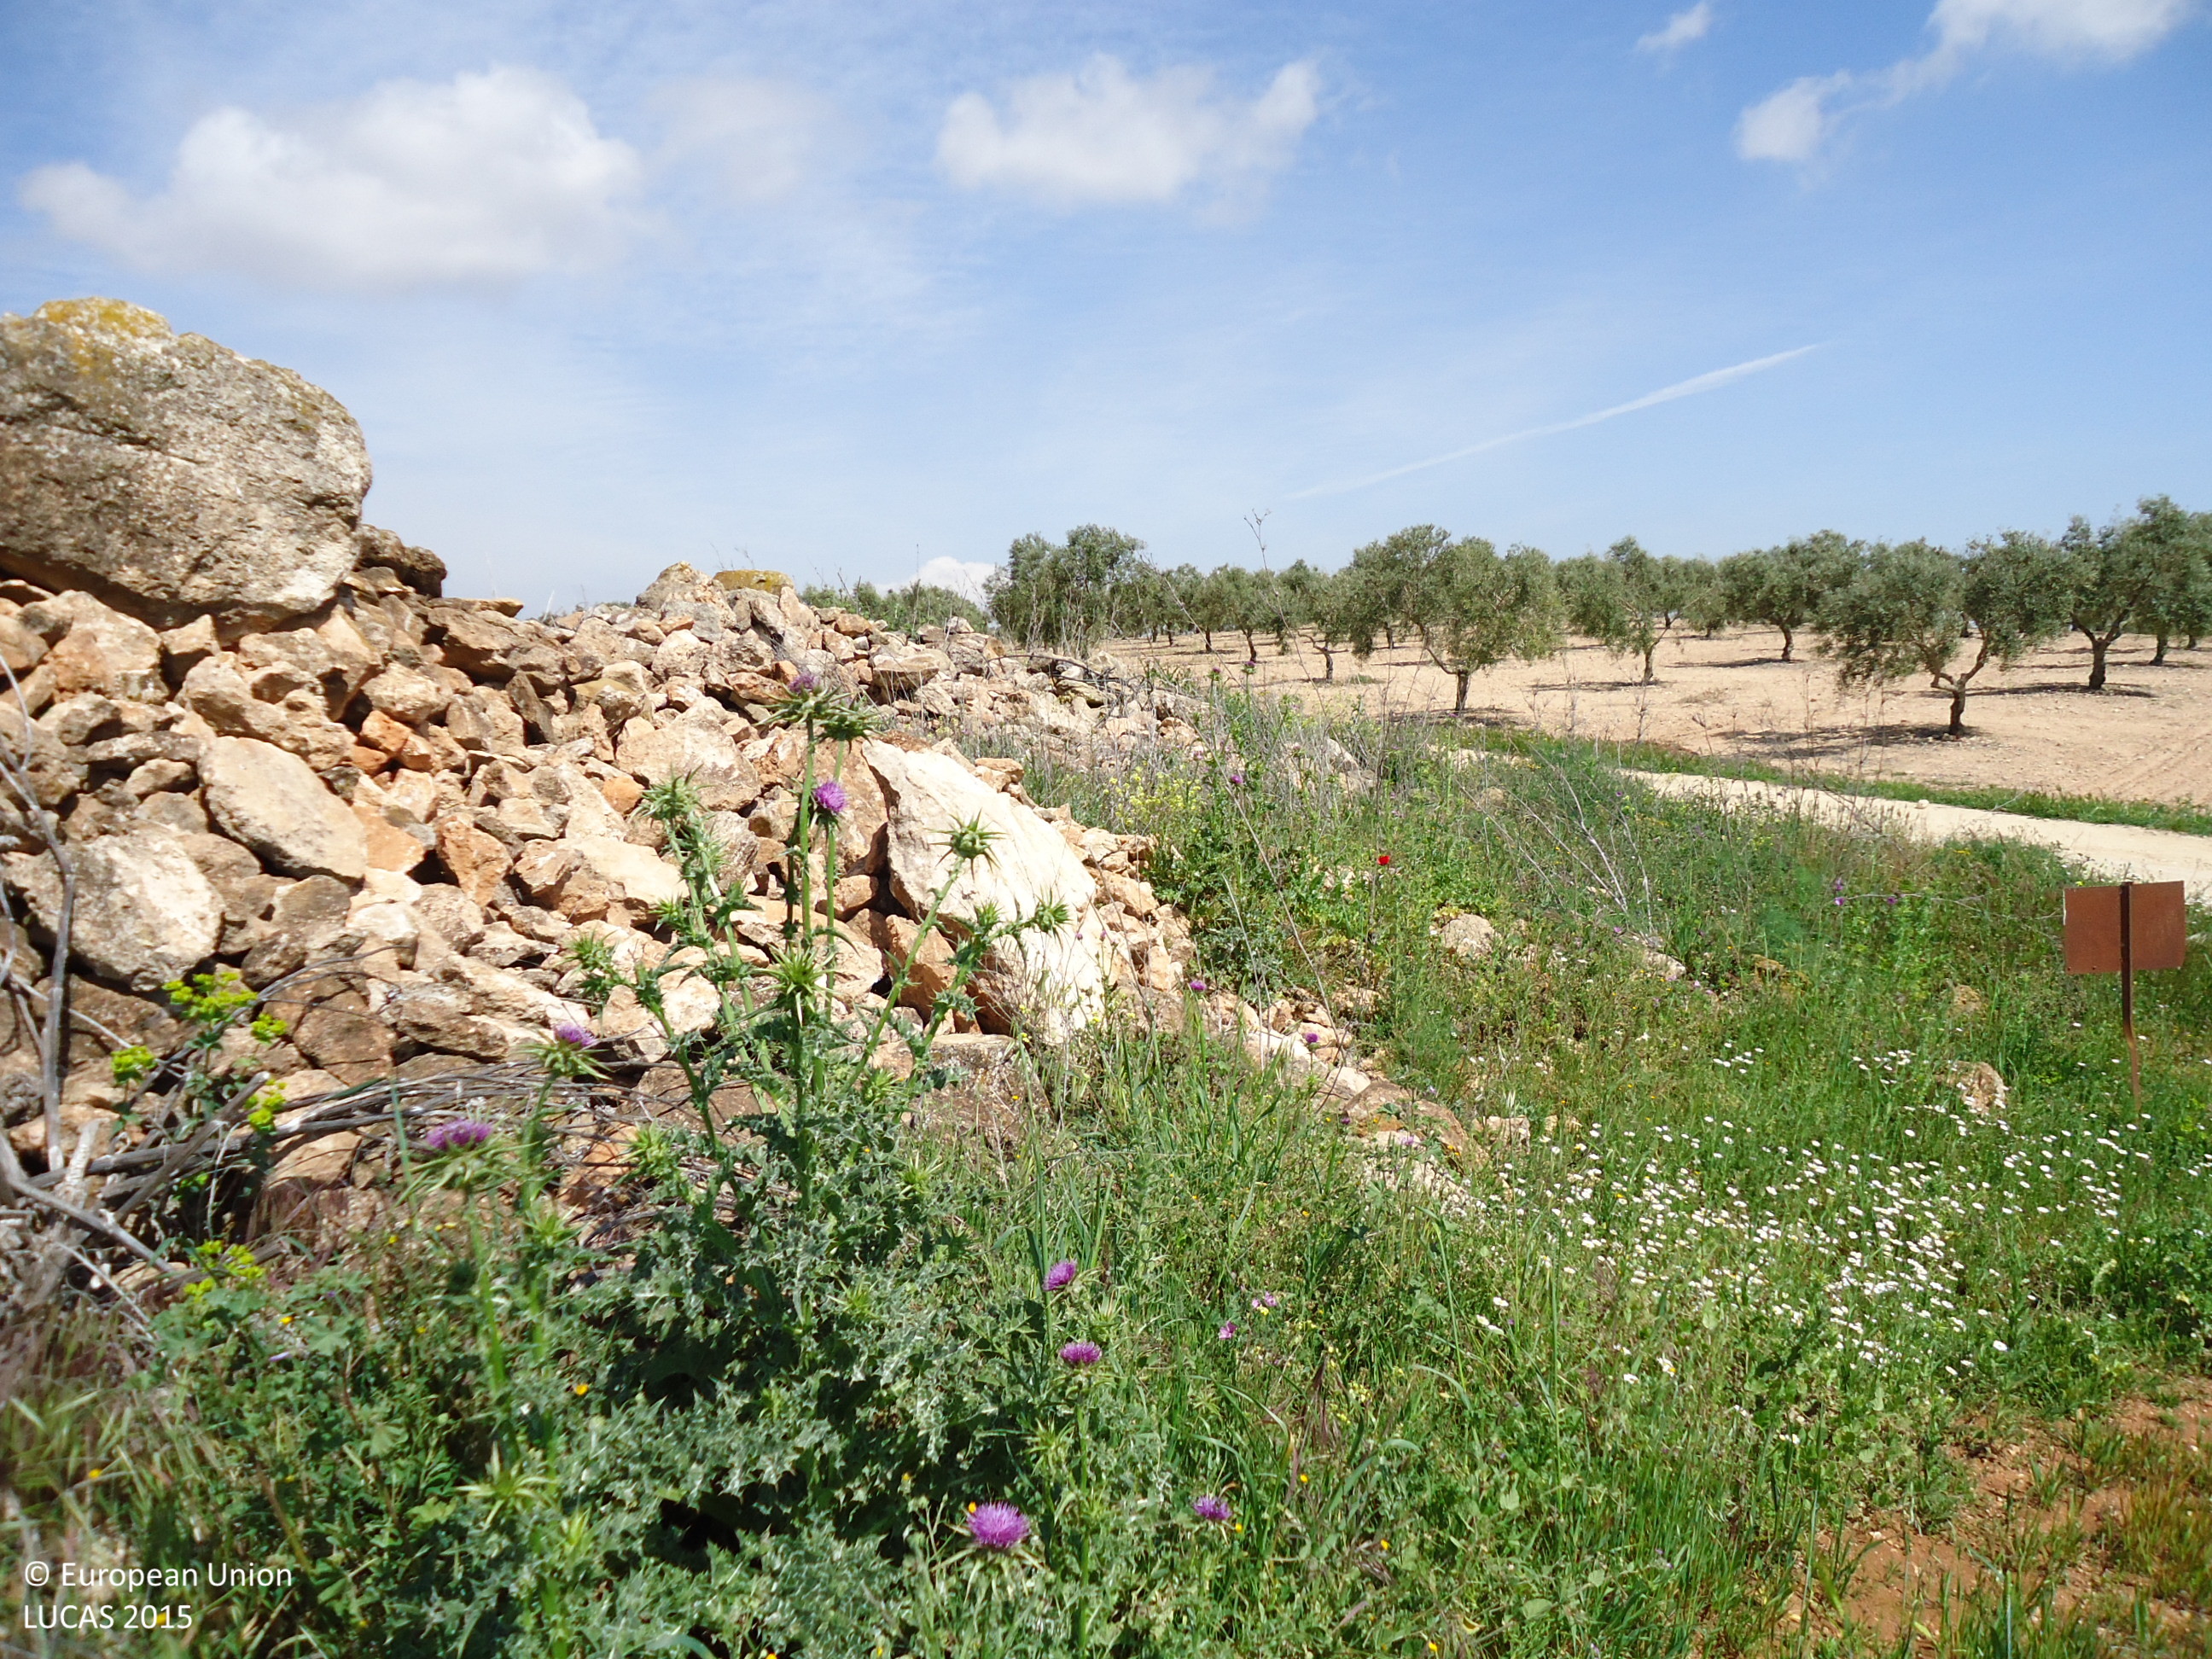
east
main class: Cropland
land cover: Oats
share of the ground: > 75 %
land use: Agriculture (excluding fallow land and kitchen gardens)
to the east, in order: Oats; Dry stone walls; Grass margins; Tracks; Grass margins; Olive groves; Grassland without tree/shrub cover; Olive groves
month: April
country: ES
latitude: 37.0414
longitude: -4.8073
